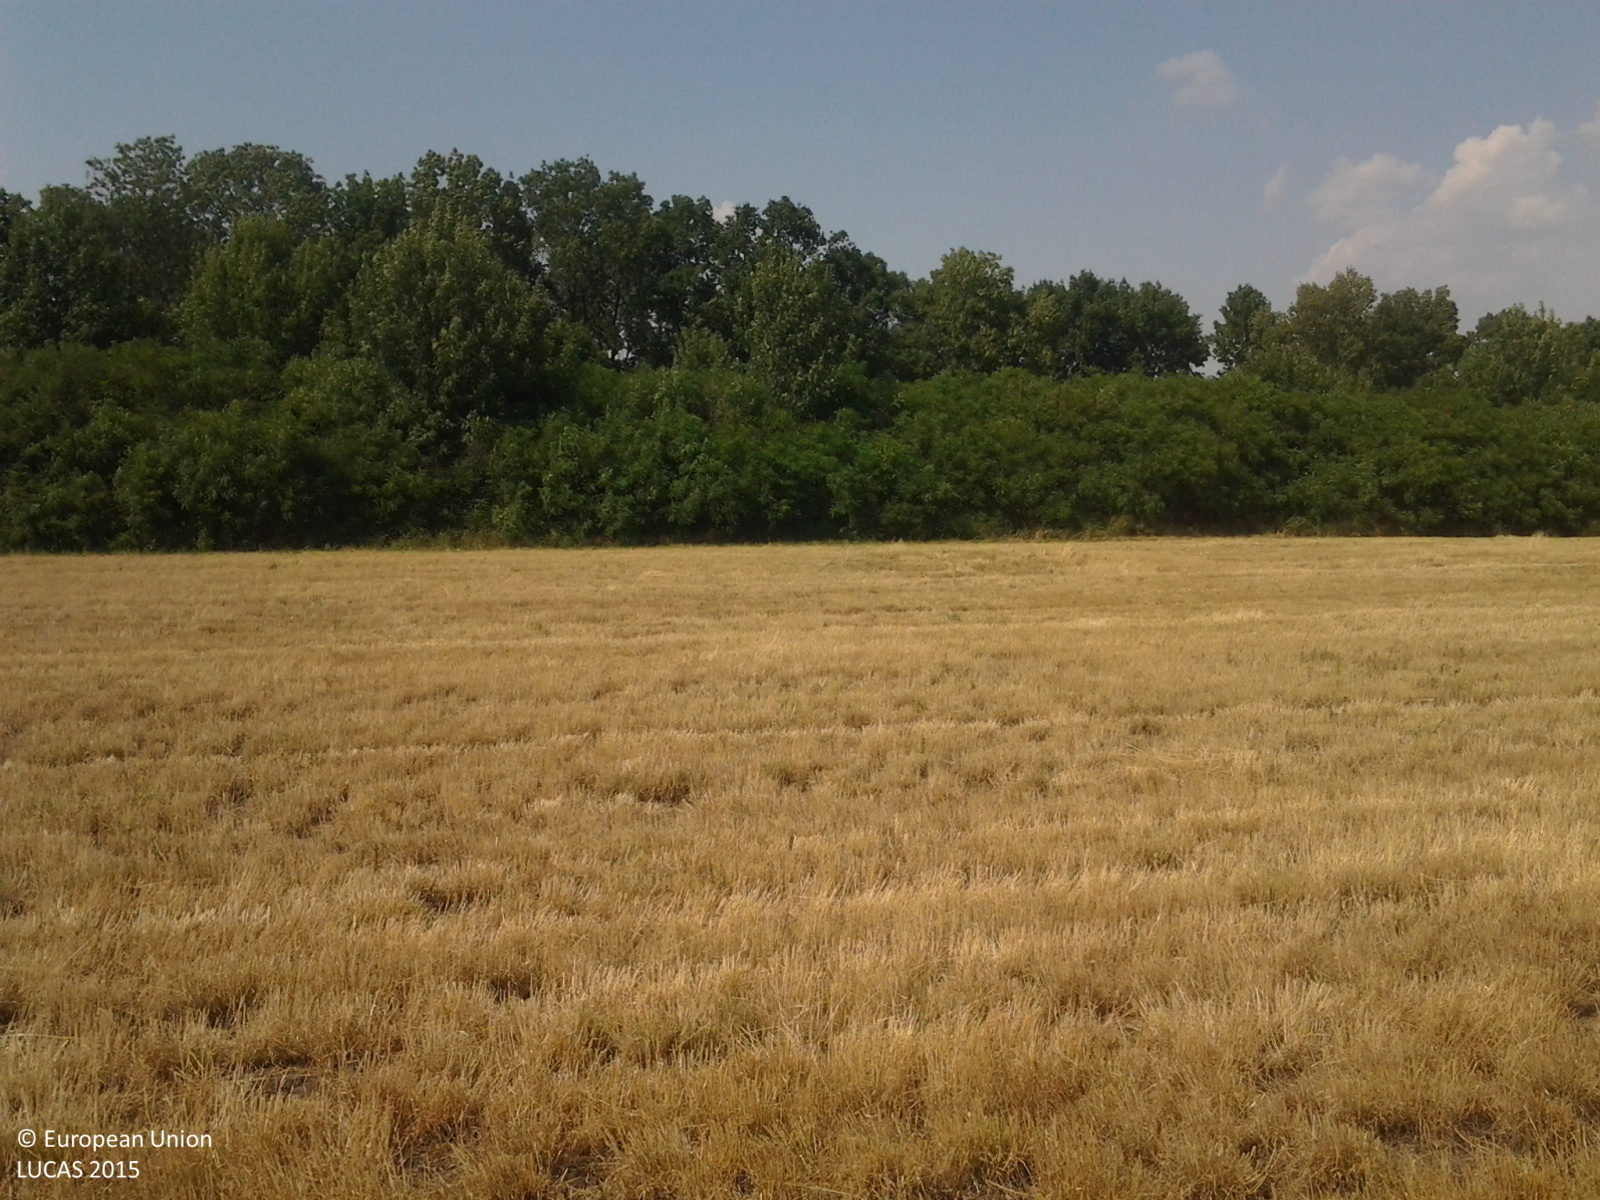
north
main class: Cropland
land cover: Common wheat
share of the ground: < 10 %
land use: Agriculture (excluding fallow land and kitchen gardens)
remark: Harvested field
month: July
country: HU
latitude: 47.2454
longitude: 20.7205
